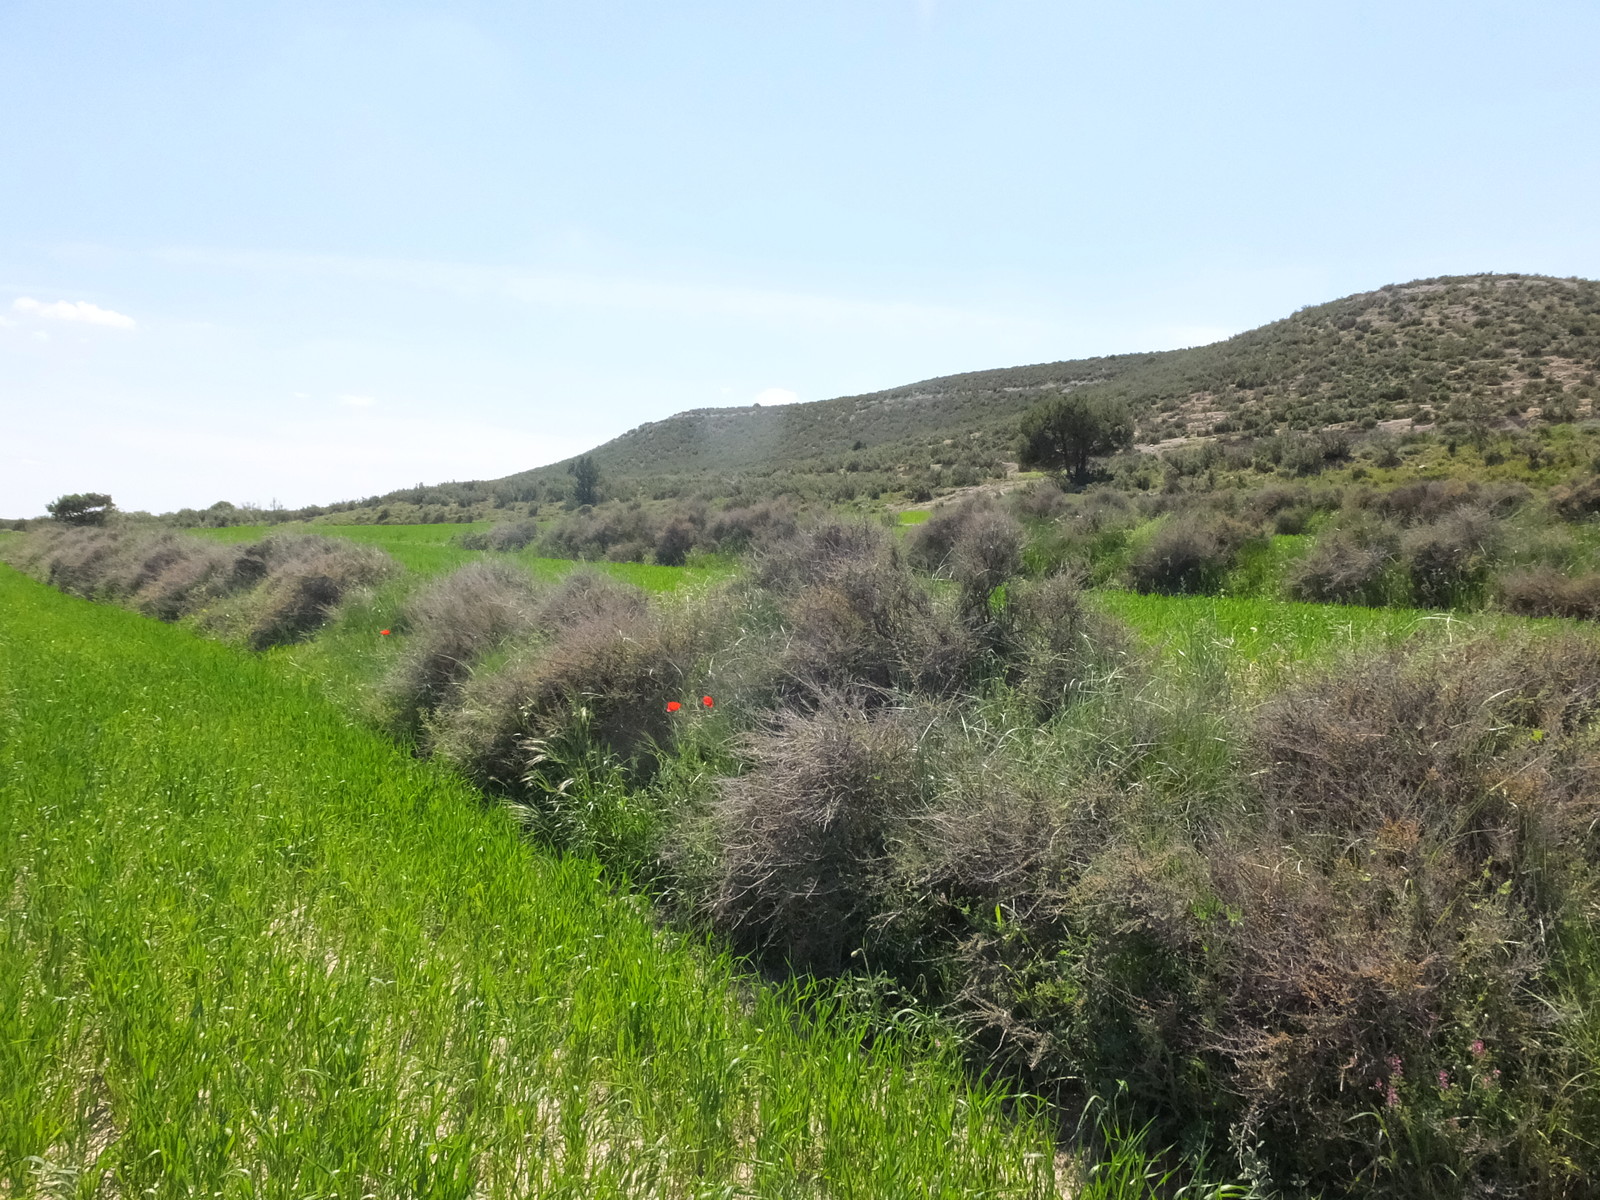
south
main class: Cropland
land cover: Durum wheat
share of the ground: > 75 %
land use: Agriculture (excluding fallow land and kitchen gardens)
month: April
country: ES
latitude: 41.6276
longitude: -0.2075
